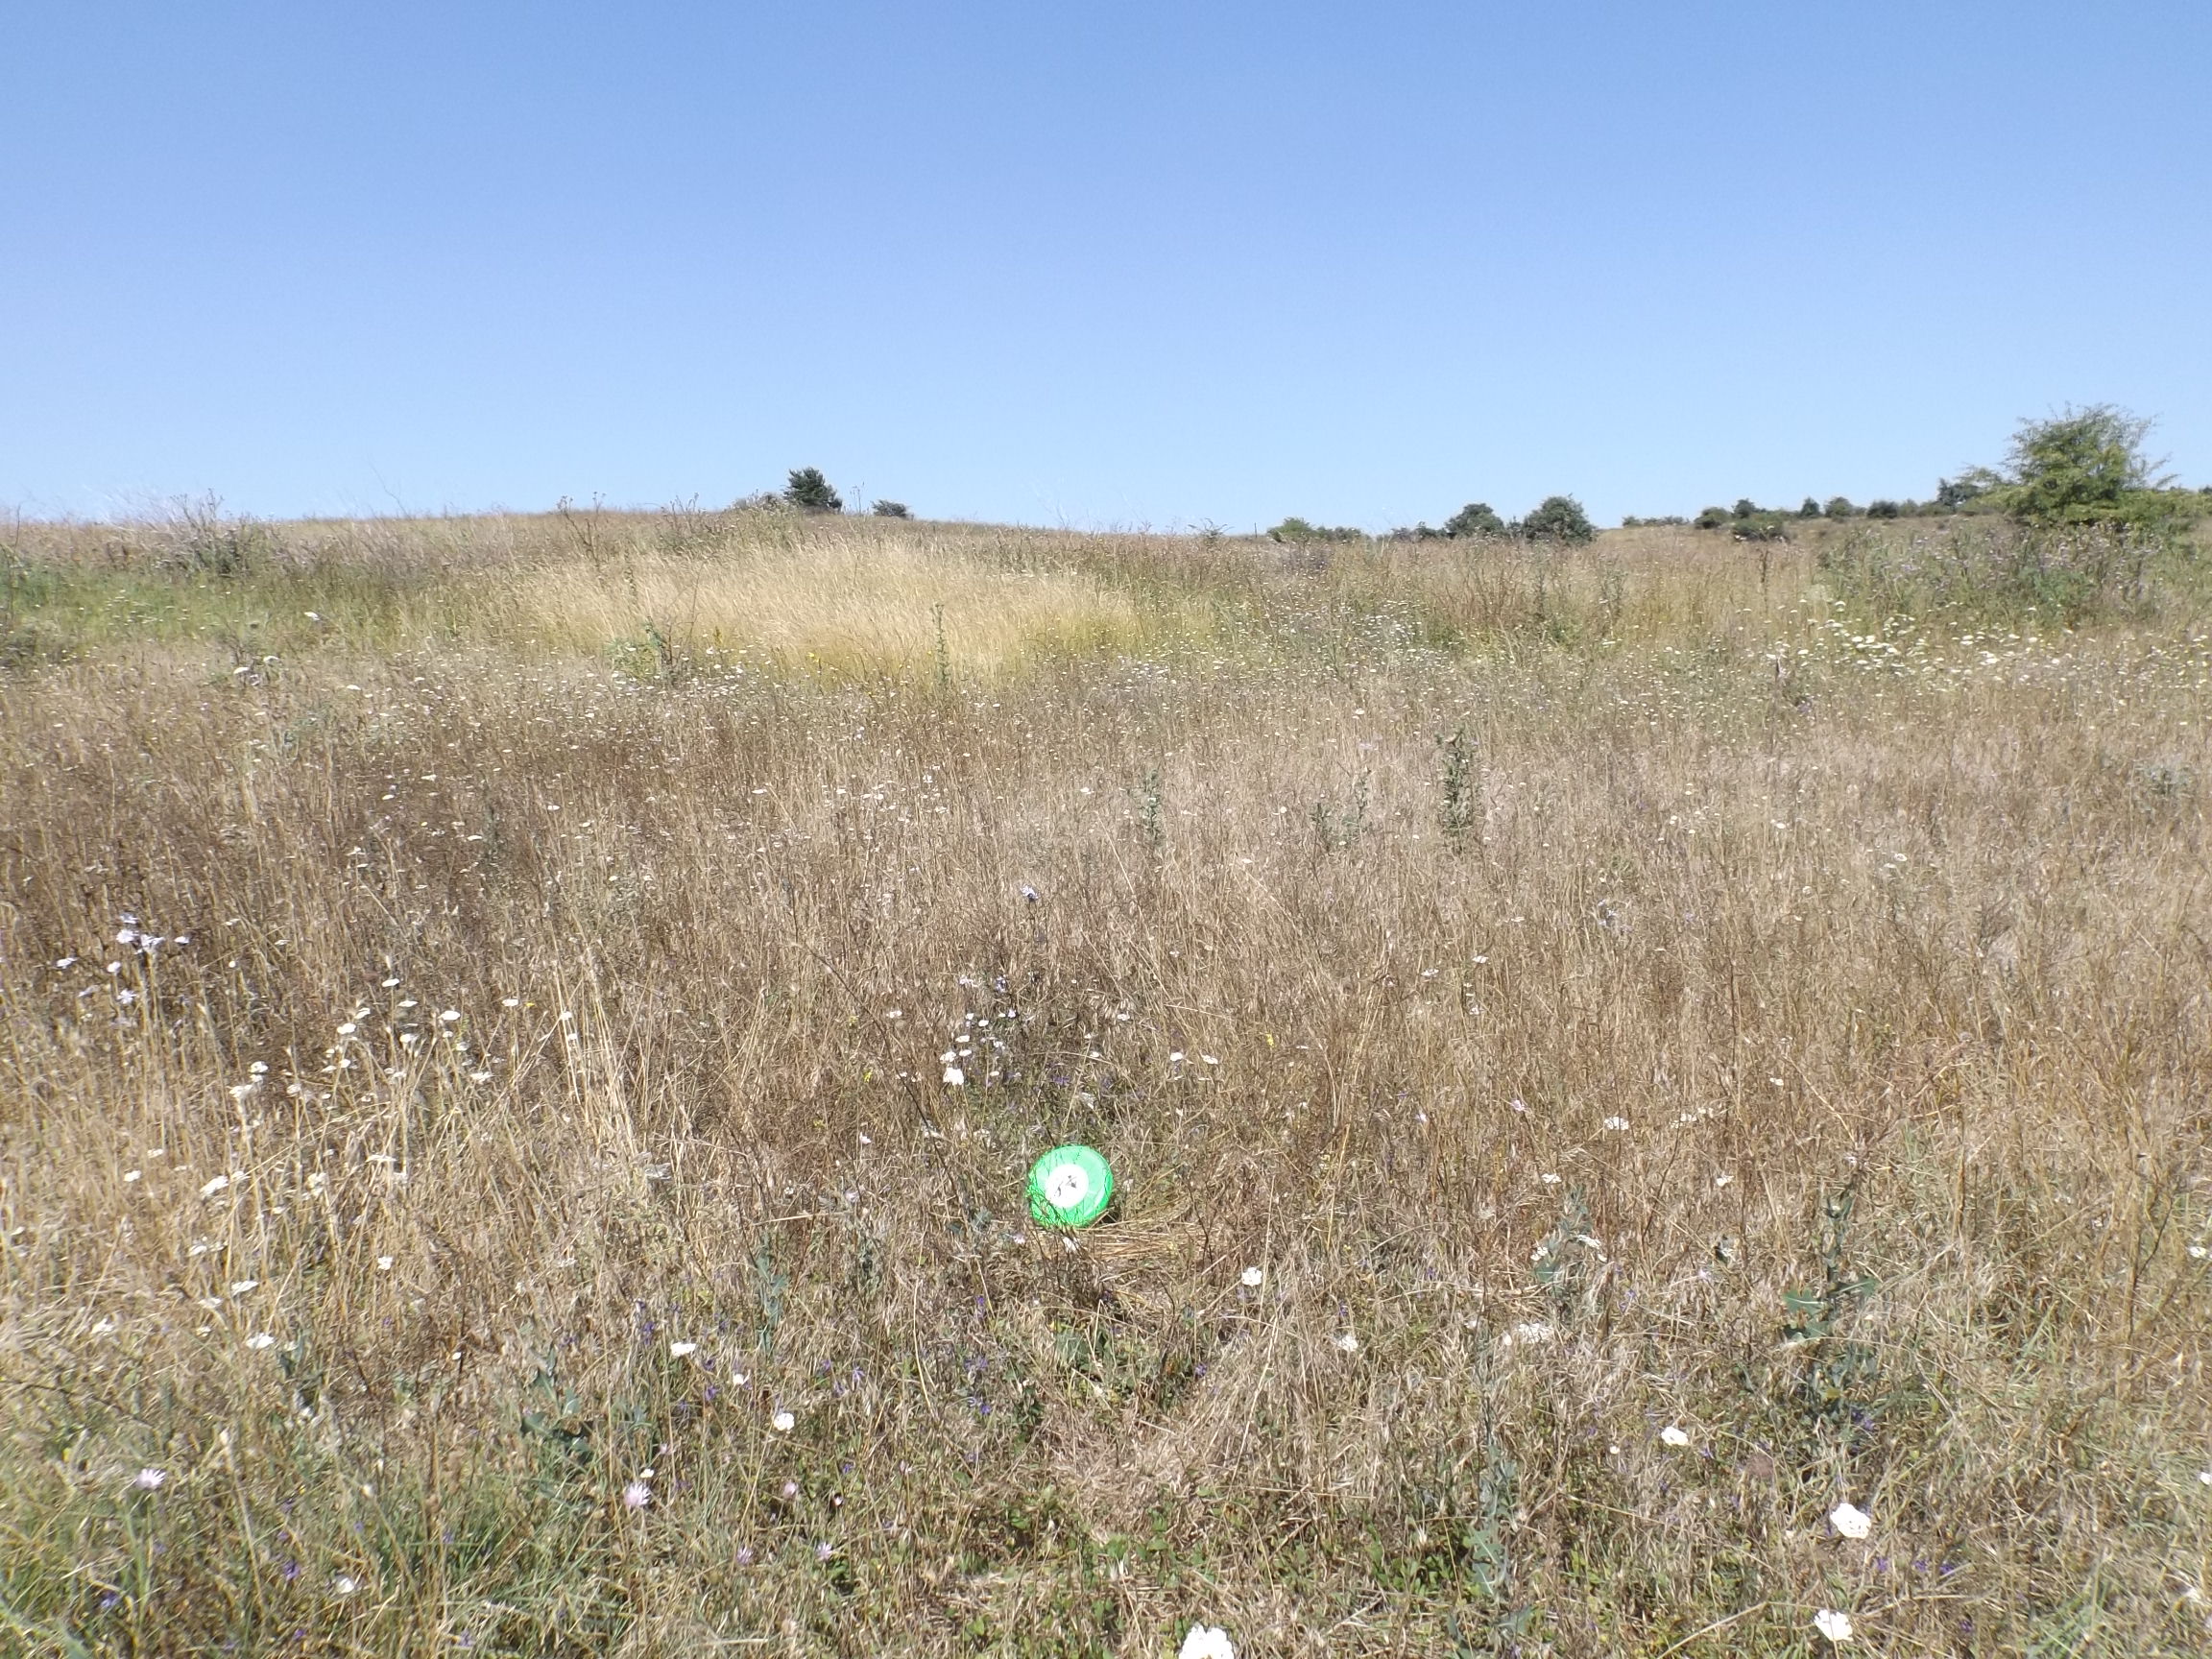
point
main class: Grassland
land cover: Grassland without tree/shrub cover
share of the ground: > 75 %
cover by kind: herbaceous plants 100 %
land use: Semi-natural and natural areas not in use
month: August
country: BG
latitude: 43.3559
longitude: 27.9715
